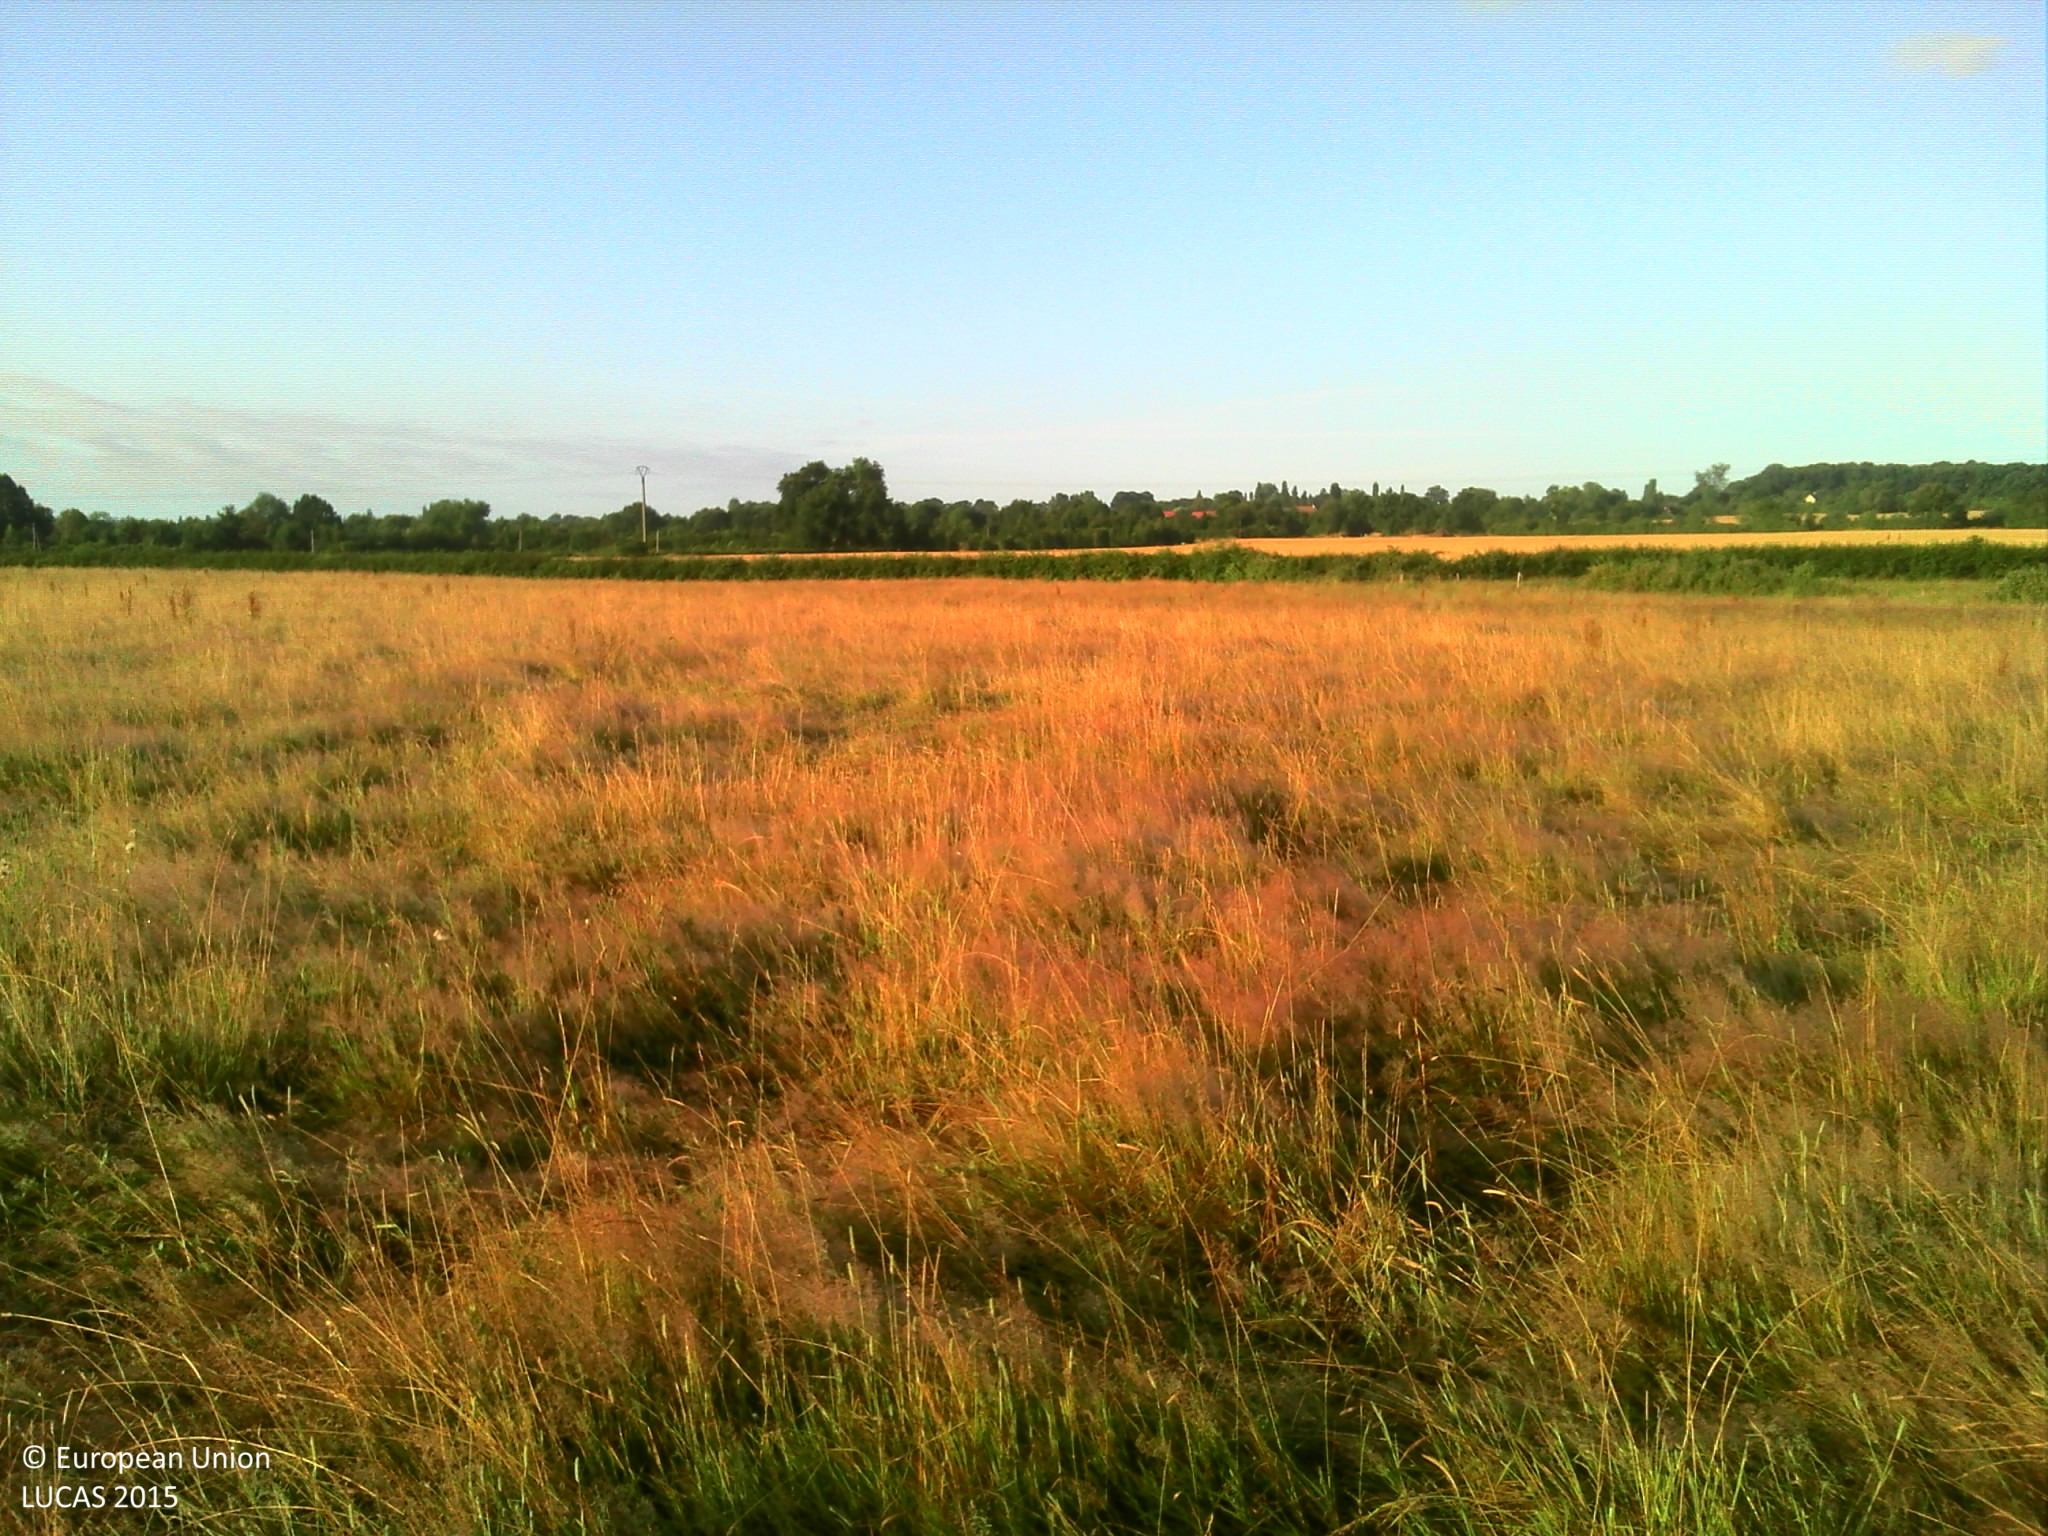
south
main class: Grassland
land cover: Grassland without tree/shrub cover
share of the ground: > 75 %
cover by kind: herbaceous plants 100 %
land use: Agriculture (excluding fallow land and kitchen gardens)
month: July
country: FR
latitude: 49.0793
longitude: 0.0715
